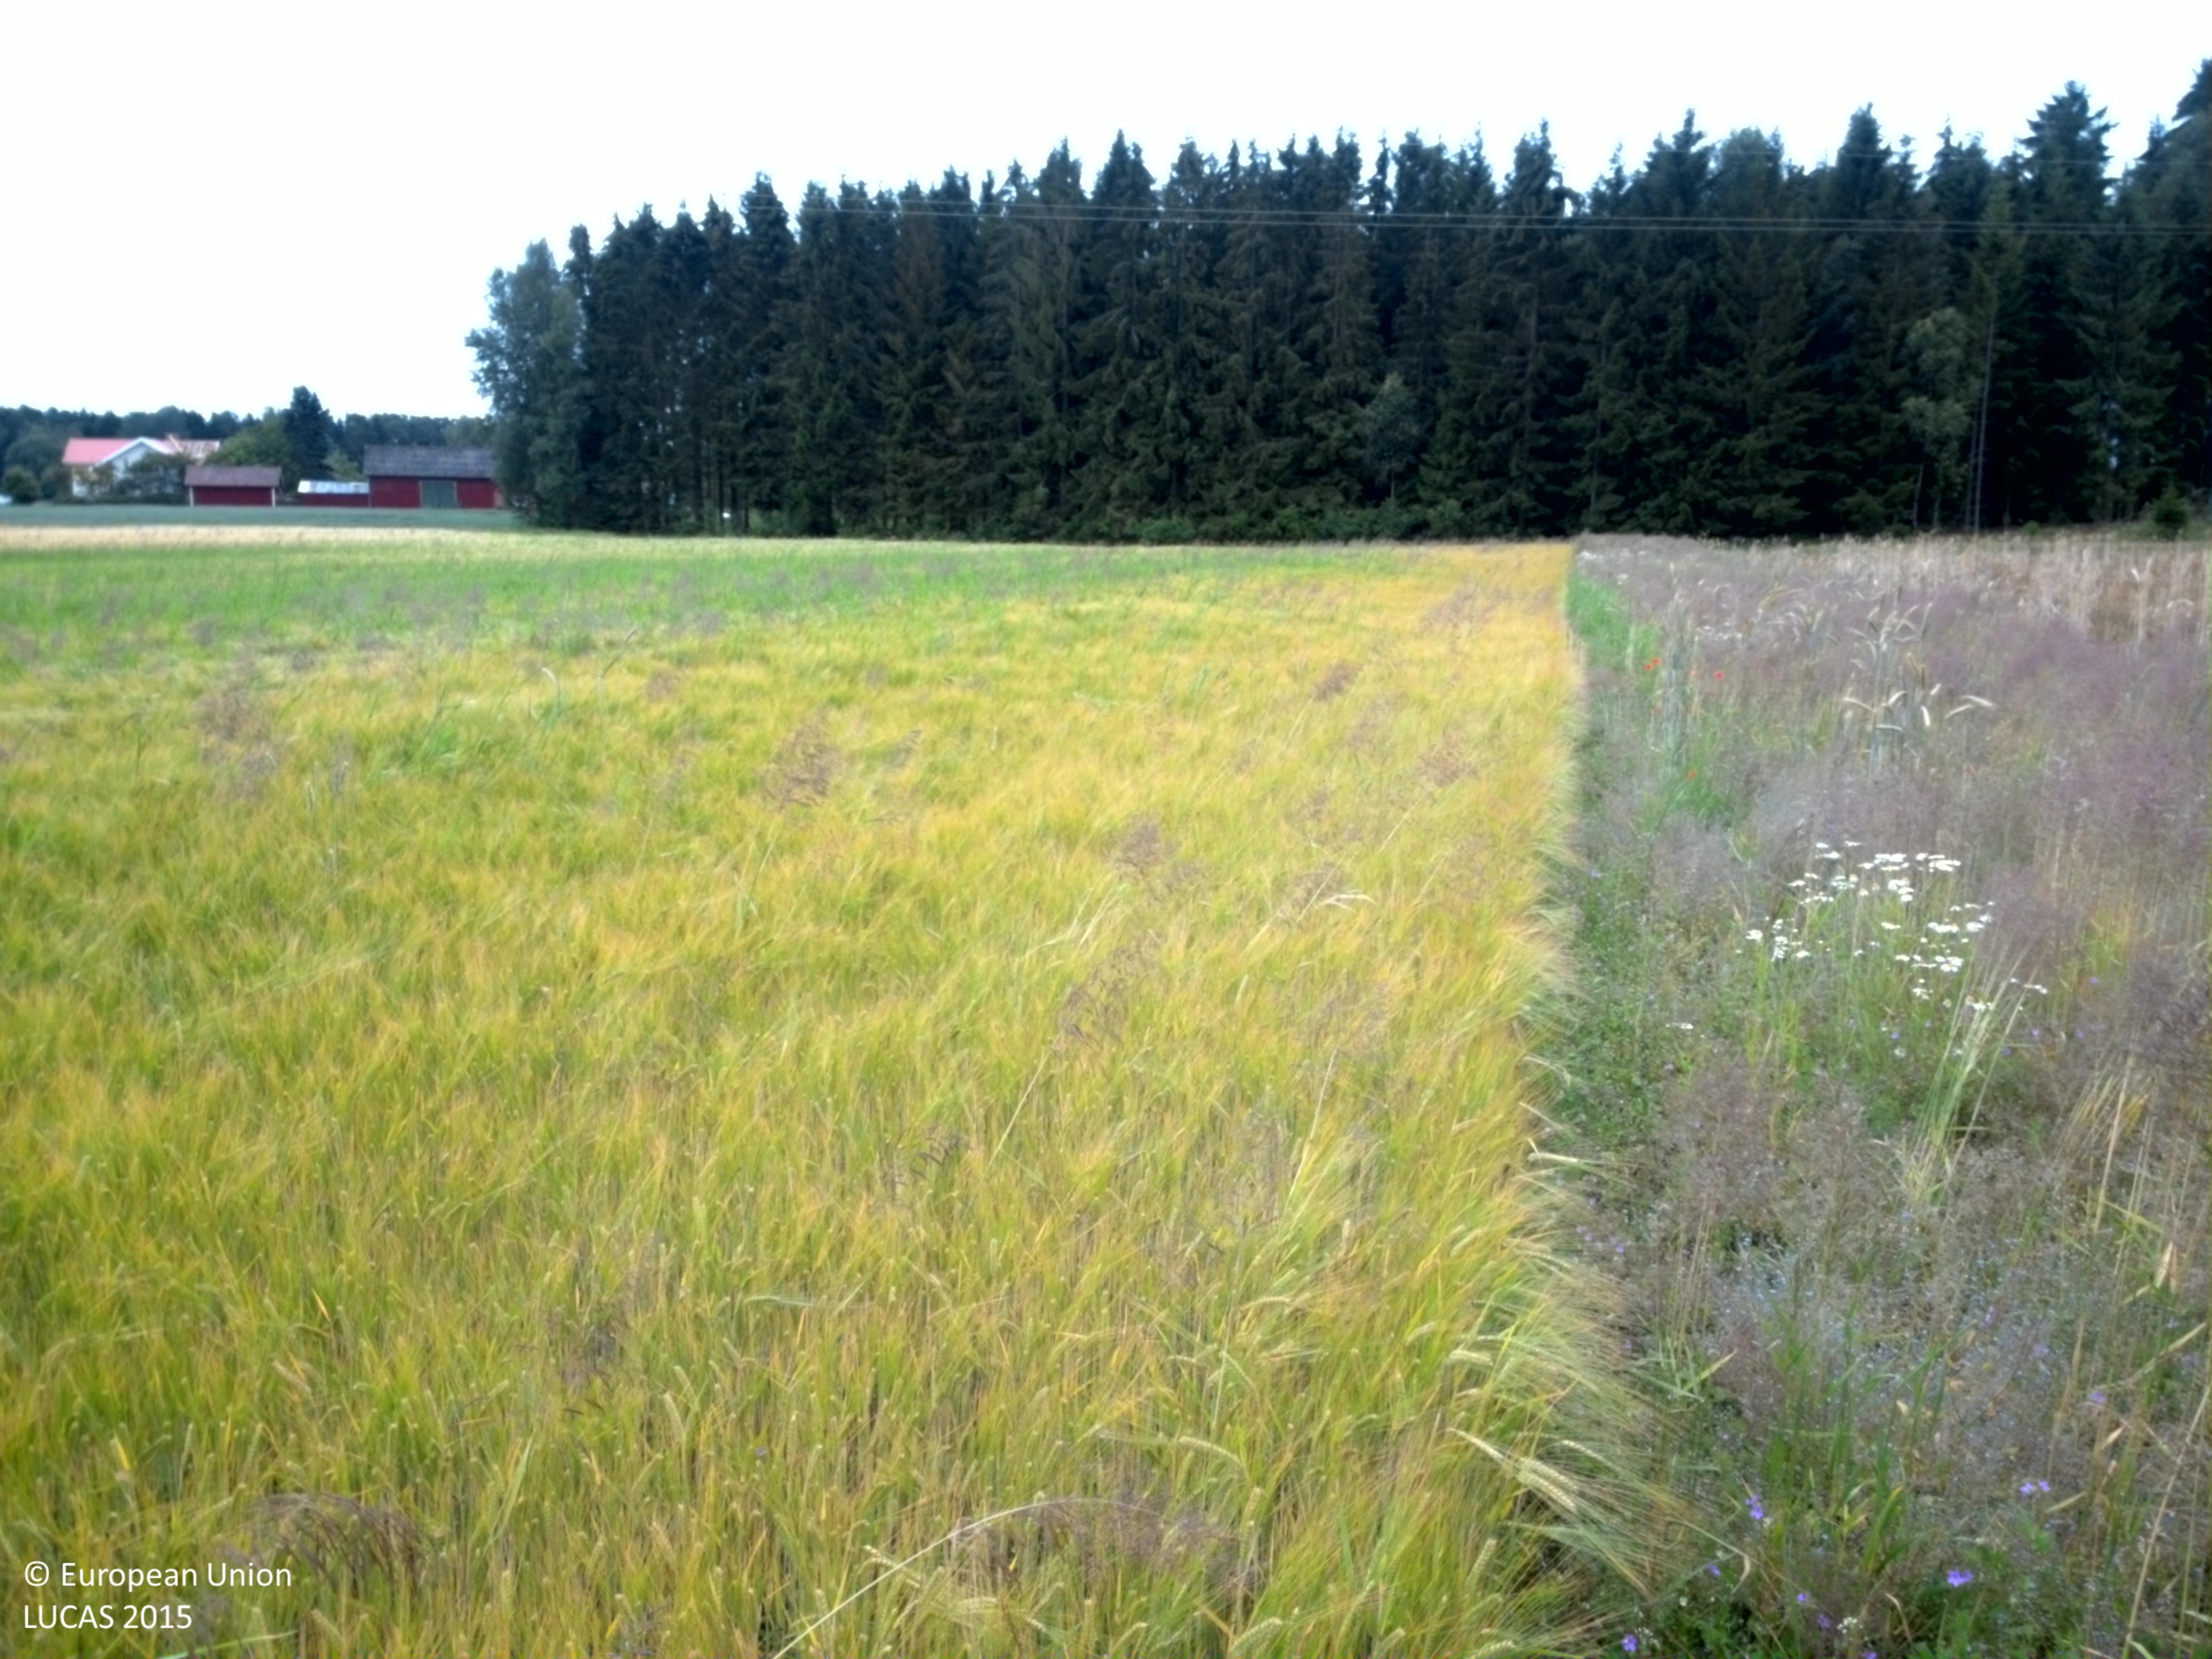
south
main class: Cropland
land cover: Barley
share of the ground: > 75 %
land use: Agriculture (excluding fallow land and kitchen gardens)
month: July
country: SE
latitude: 58.3764
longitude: 13.3285
